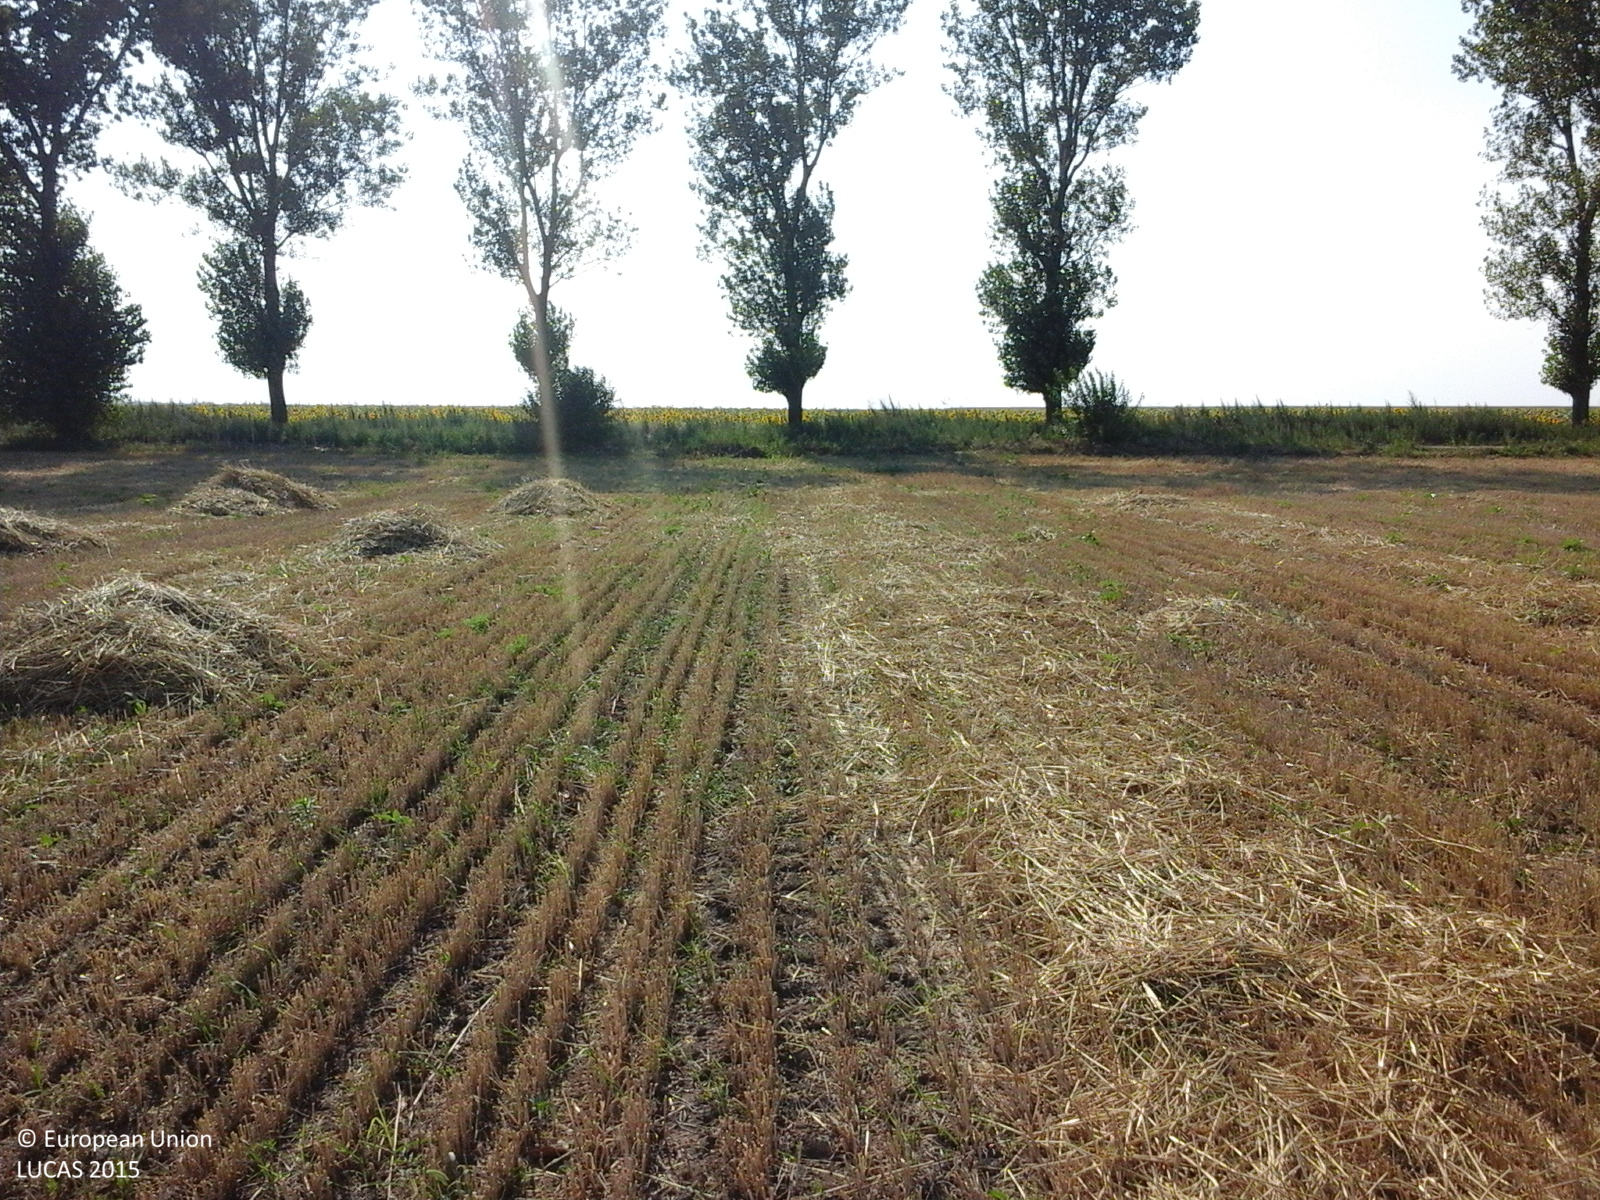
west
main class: Cropland
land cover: Common wheat
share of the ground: 50 - 75 %
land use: Agriculture (excluding fallow land and kitchen gardens)
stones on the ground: < 10 %
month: July
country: RO
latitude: 44.7688
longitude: 27.2596
